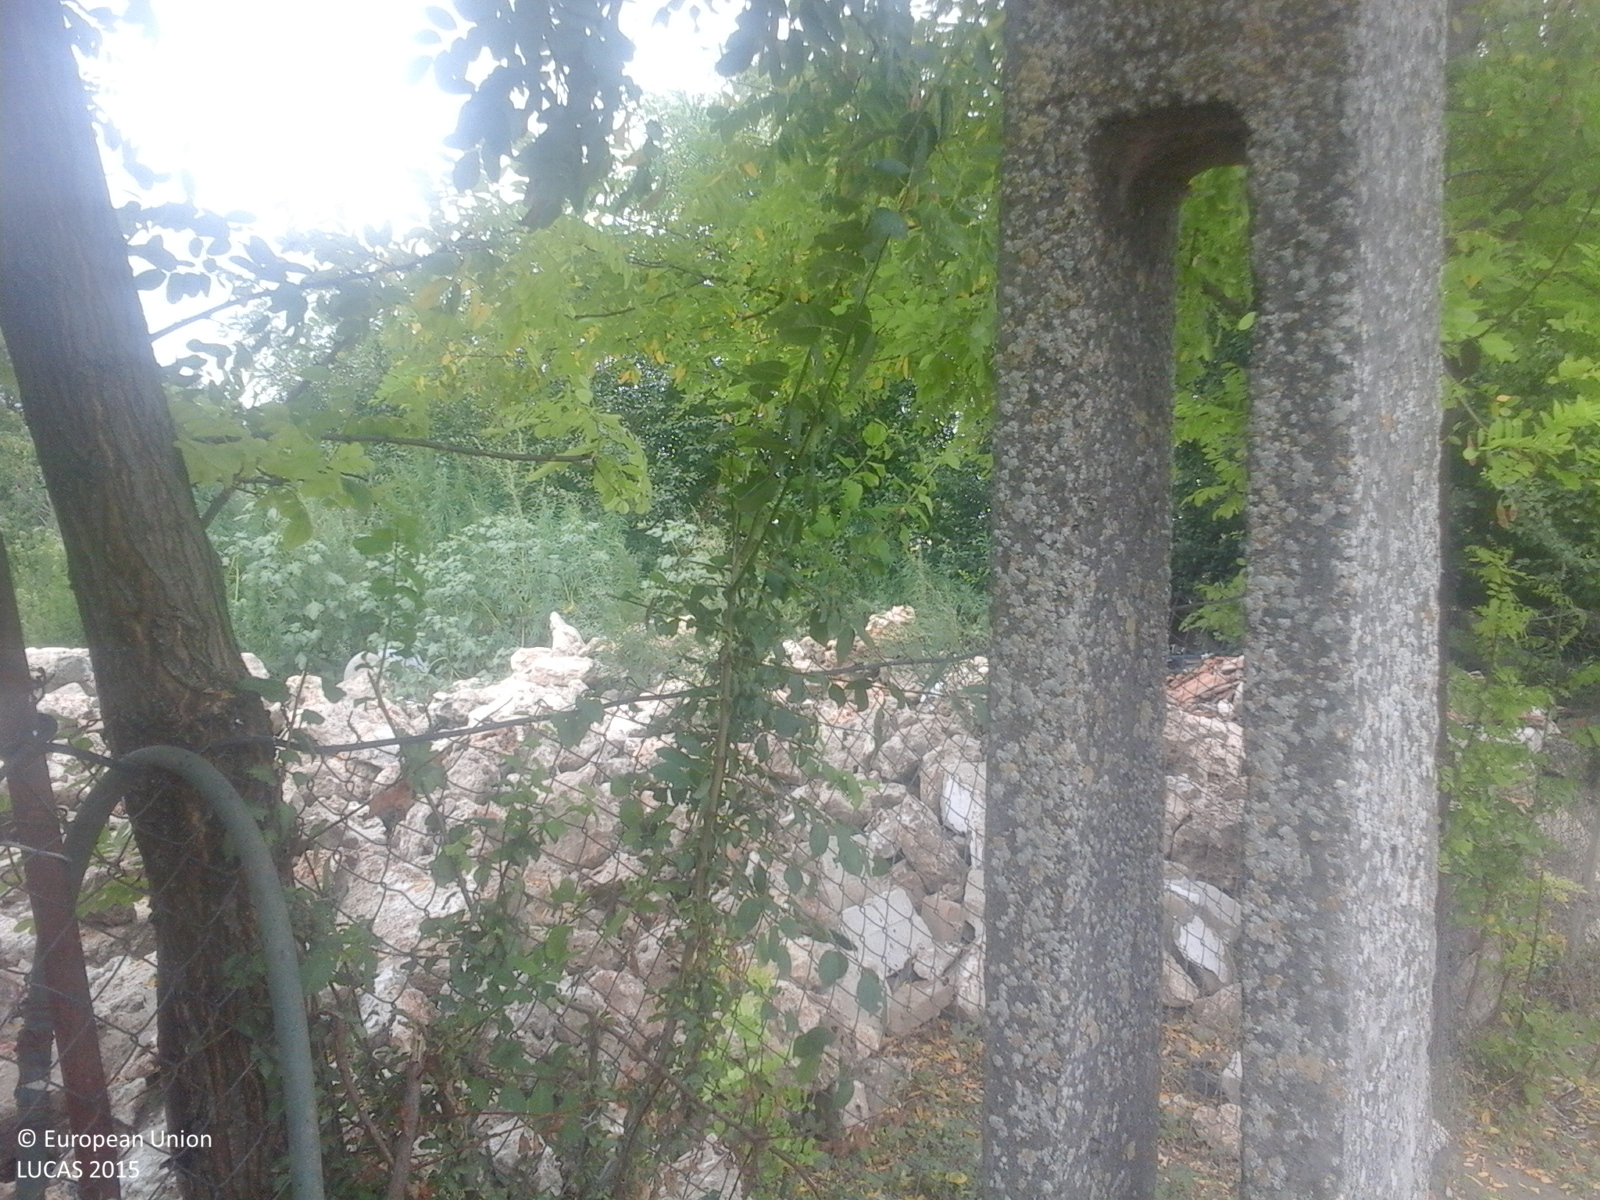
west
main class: Grassland
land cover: Spontaneously vegetated surfaces
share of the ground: > 75 %
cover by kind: herbaceous plants 100 %
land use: Fallow land
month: August
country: RO
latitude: 43.9013
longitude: 28.2228
